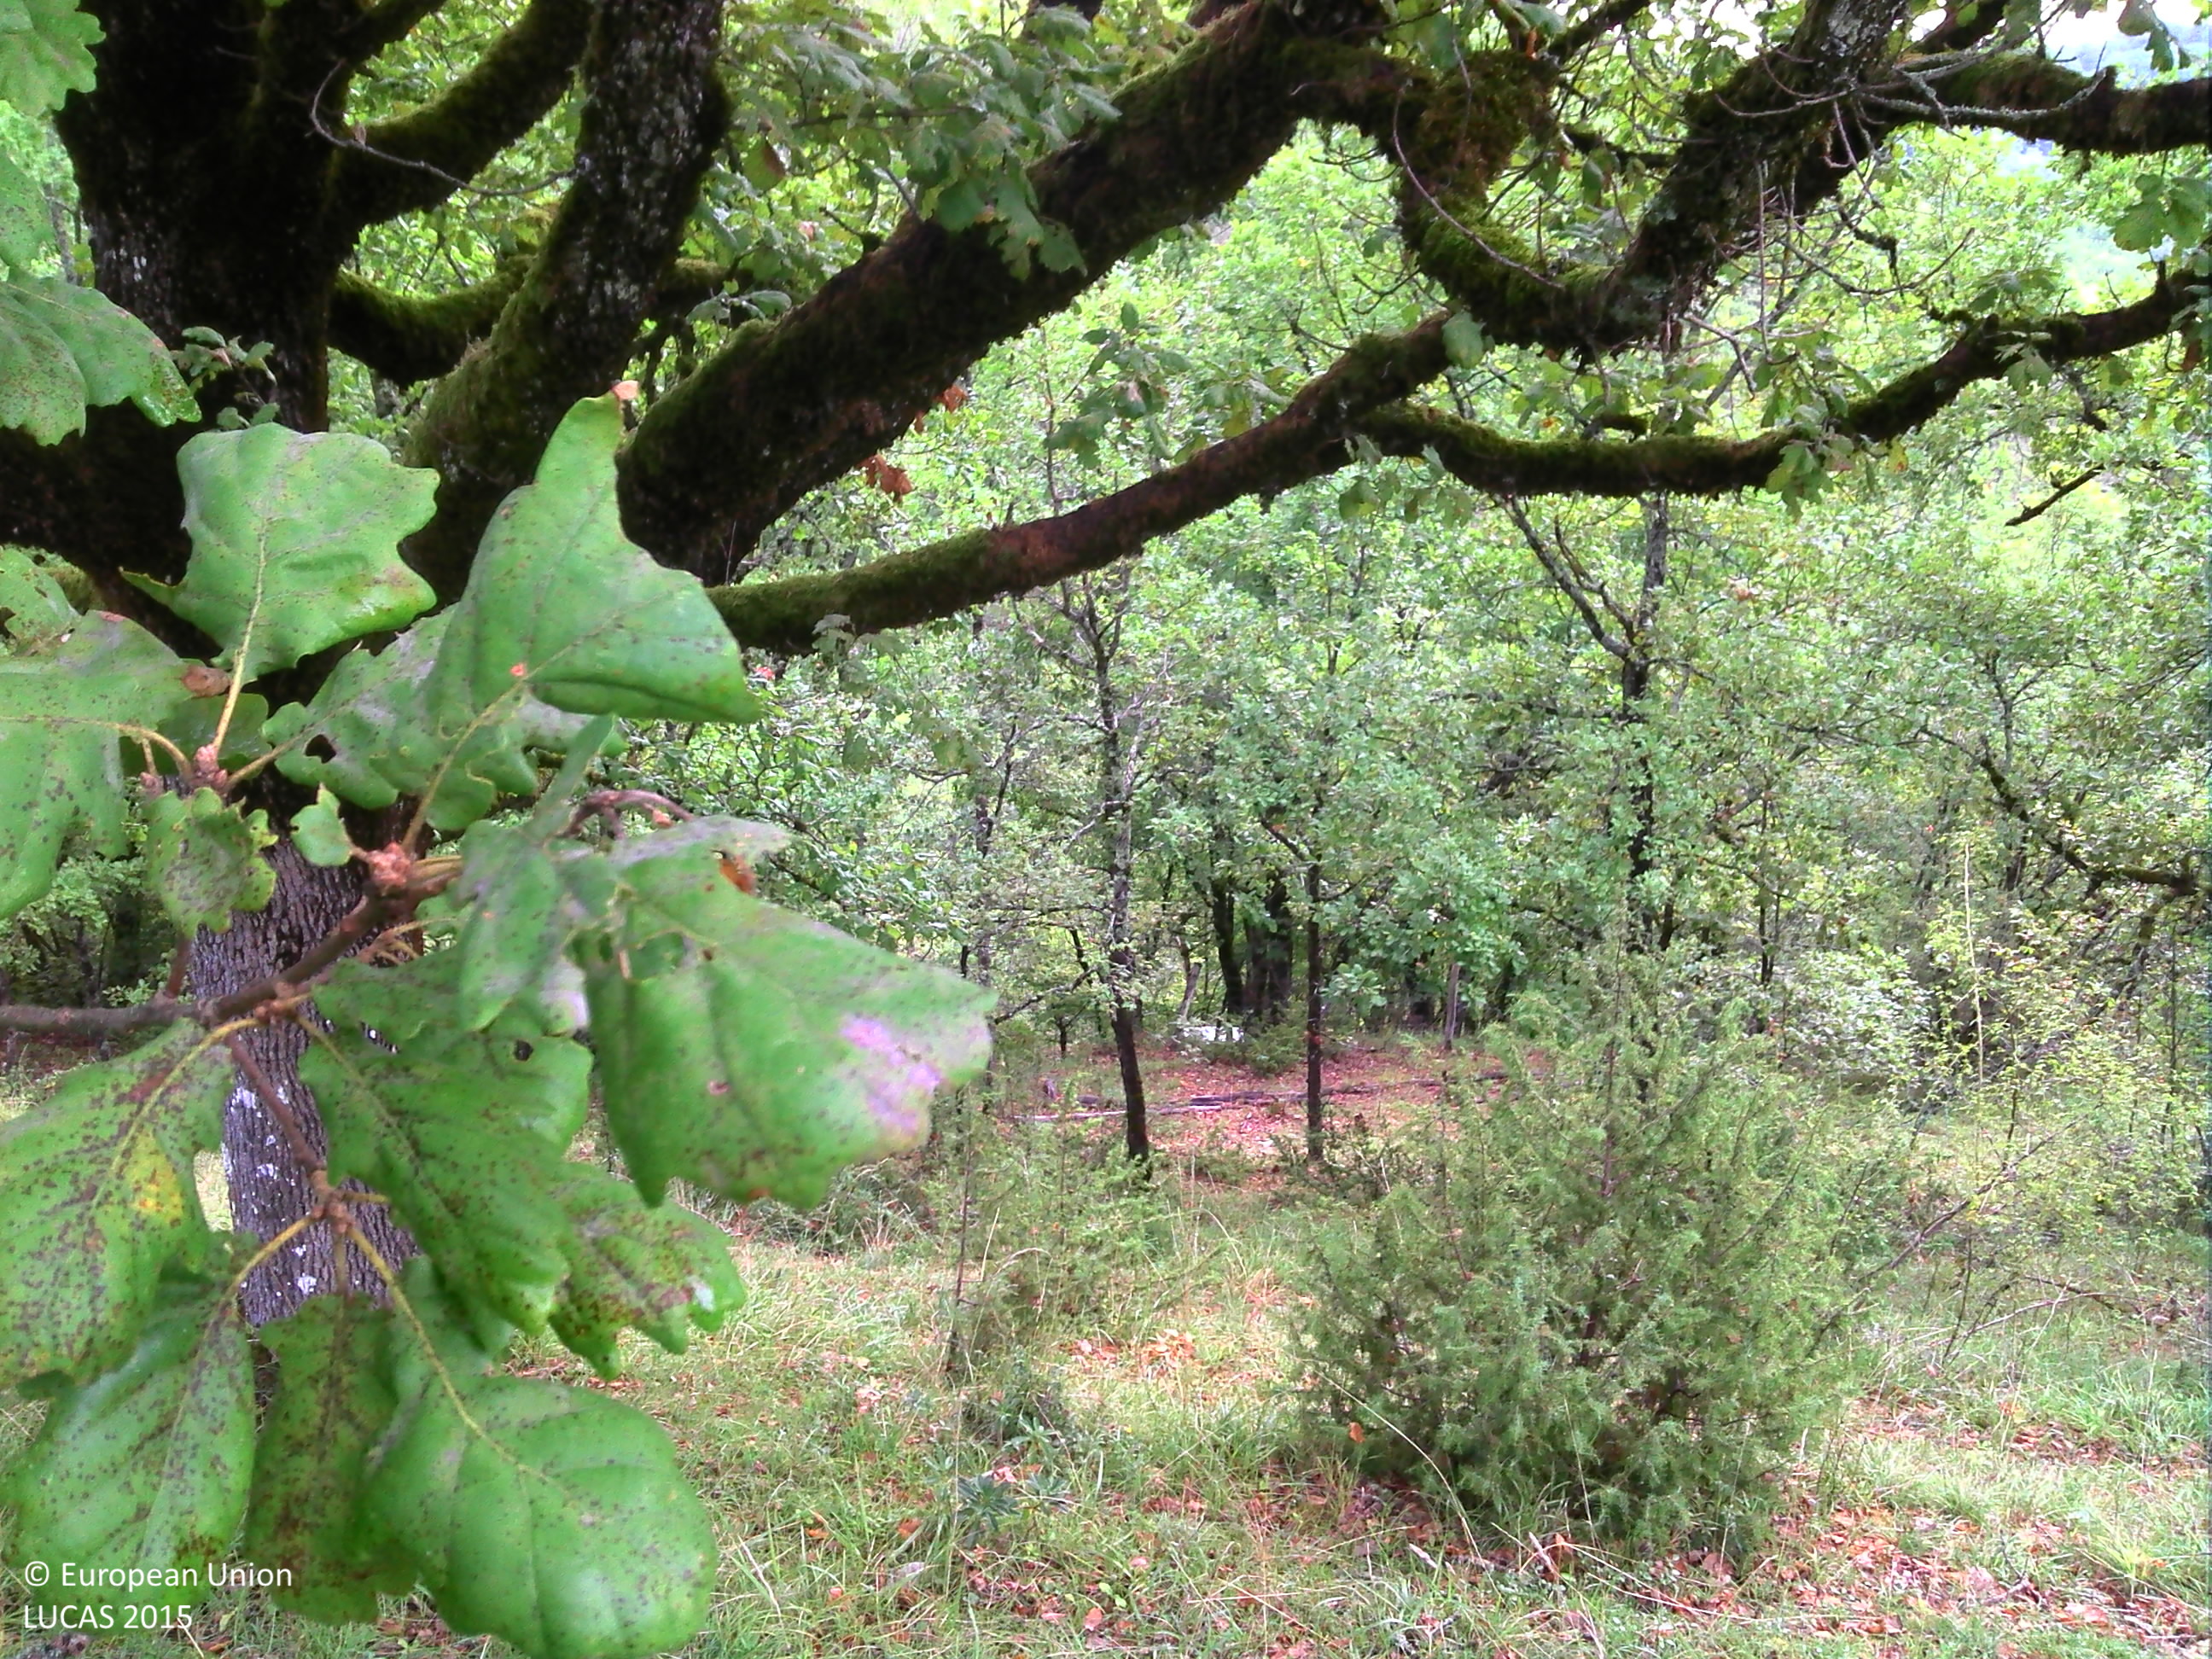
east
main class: Woodland
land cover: Broadleaved woodland
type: mesophytic deciduous forest
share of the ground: 50 - 75 %
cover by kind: broadleaved forest trees 60 %, herbaceous plants 30 %, shrubs 10 %
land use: Forestry
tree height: > 5 m
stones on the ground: < 10 %
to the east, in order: Broadleaved woodland; Fences; Broadleaved woodland; Grass margins; Paved roads, cycling and walking lanes; Grass margins; Broadleaved woodland; Ditches and canals; Grassland without tree/shrub cover; Ditches and canals; Fences; Broadleaved woodland; Tracks; Broadleaved woodland; Grass margins; Paved roads, cycling and walking lanes; Rock outcrops; Broadleaved woodland; Fences; Broadleaved woodland
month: September
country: FR
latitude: 44.5990
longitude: 1.4938
